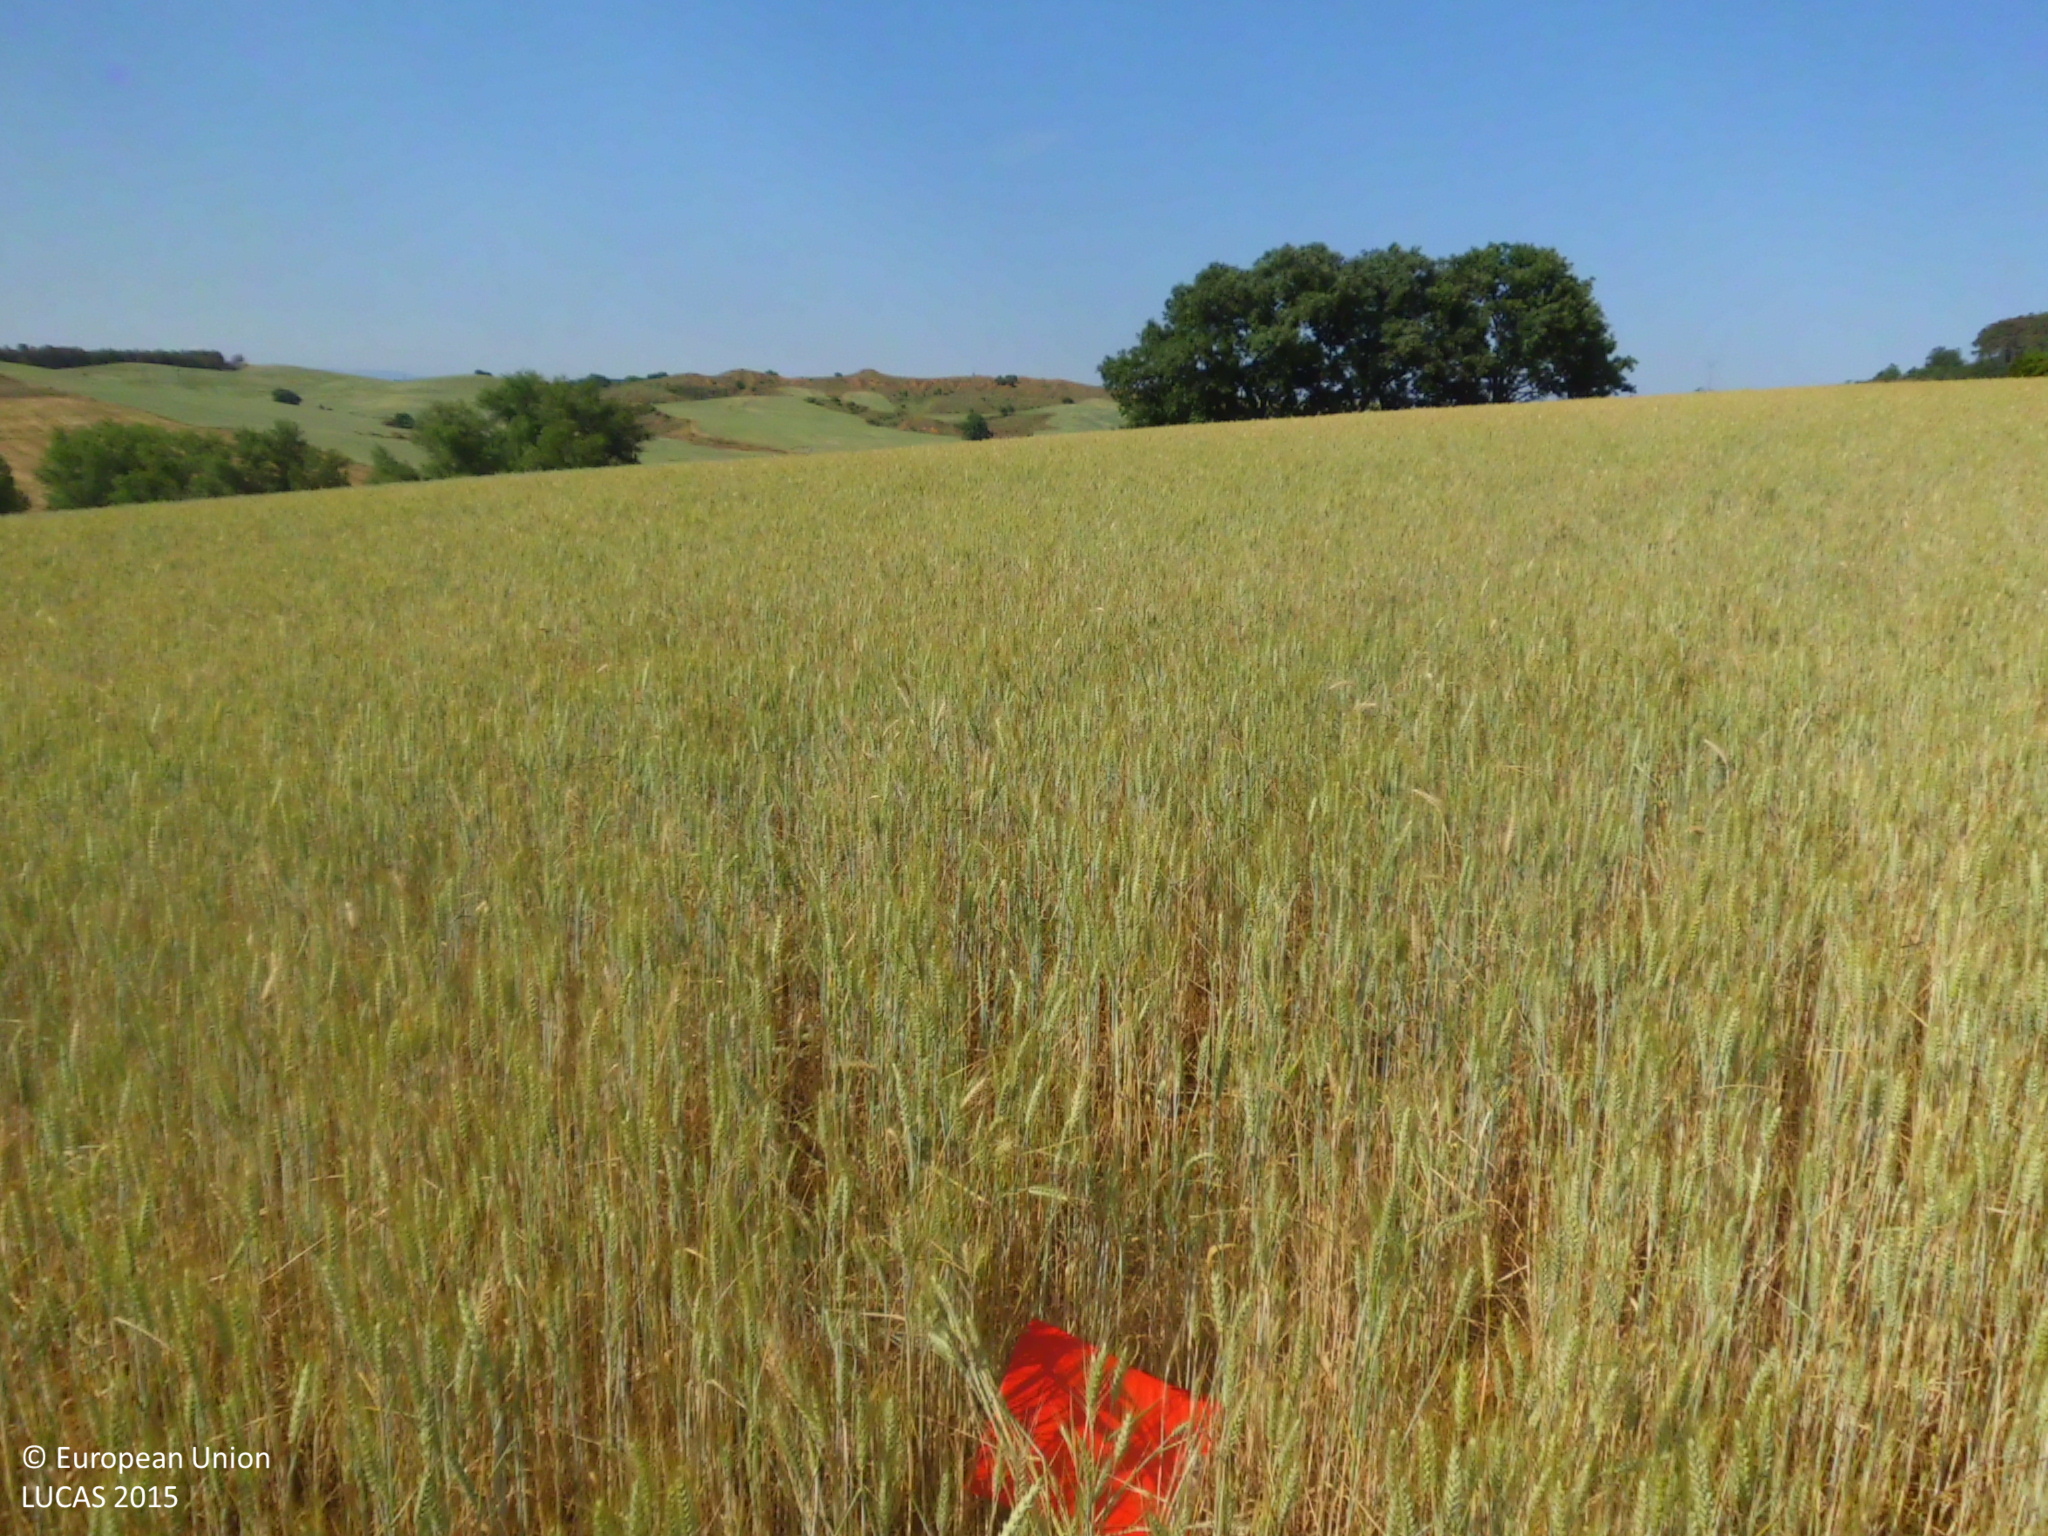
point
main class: Cropland
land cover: Common wheat
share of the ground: > 75 %
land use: Agriculture (excluding fallow land and kitchen gardens)
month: June
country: ES
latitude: 42.4878
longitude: -4.3434
